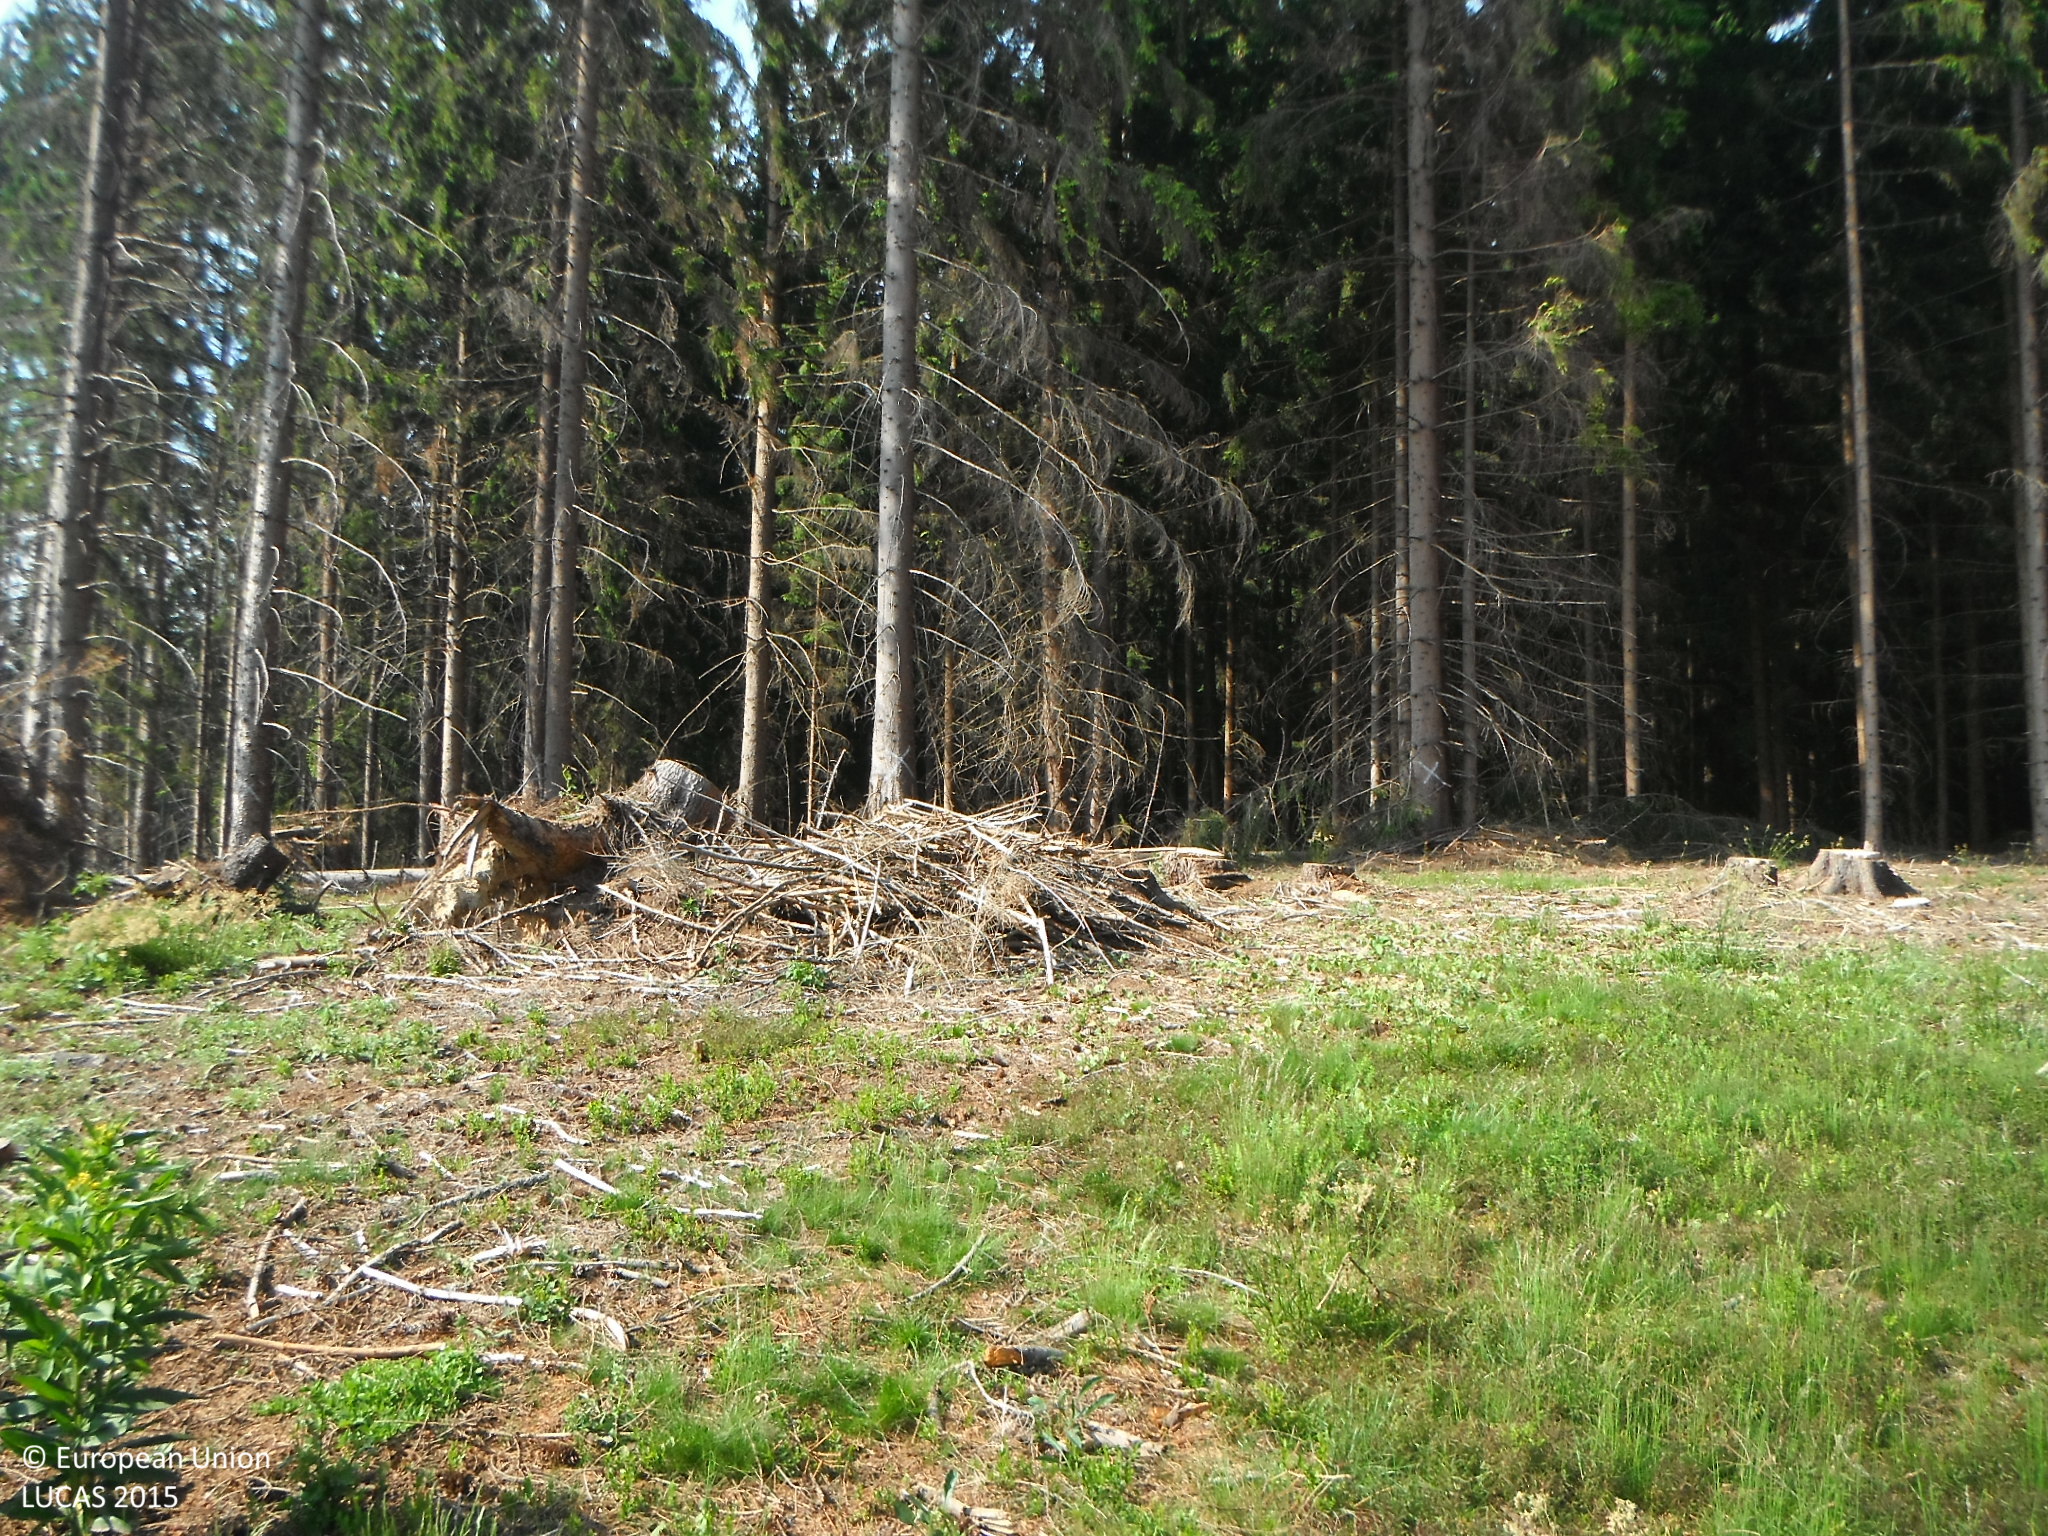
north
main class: Grassland
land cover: Spontaneously vegetated surfaces
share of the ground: > 75 %
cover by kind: herbaceous plants 75 %, unconsolidated bare surface 25 %
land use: Forestry
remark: Clear cut
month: June
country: SK
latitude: 49.0712
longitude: 19.8162
